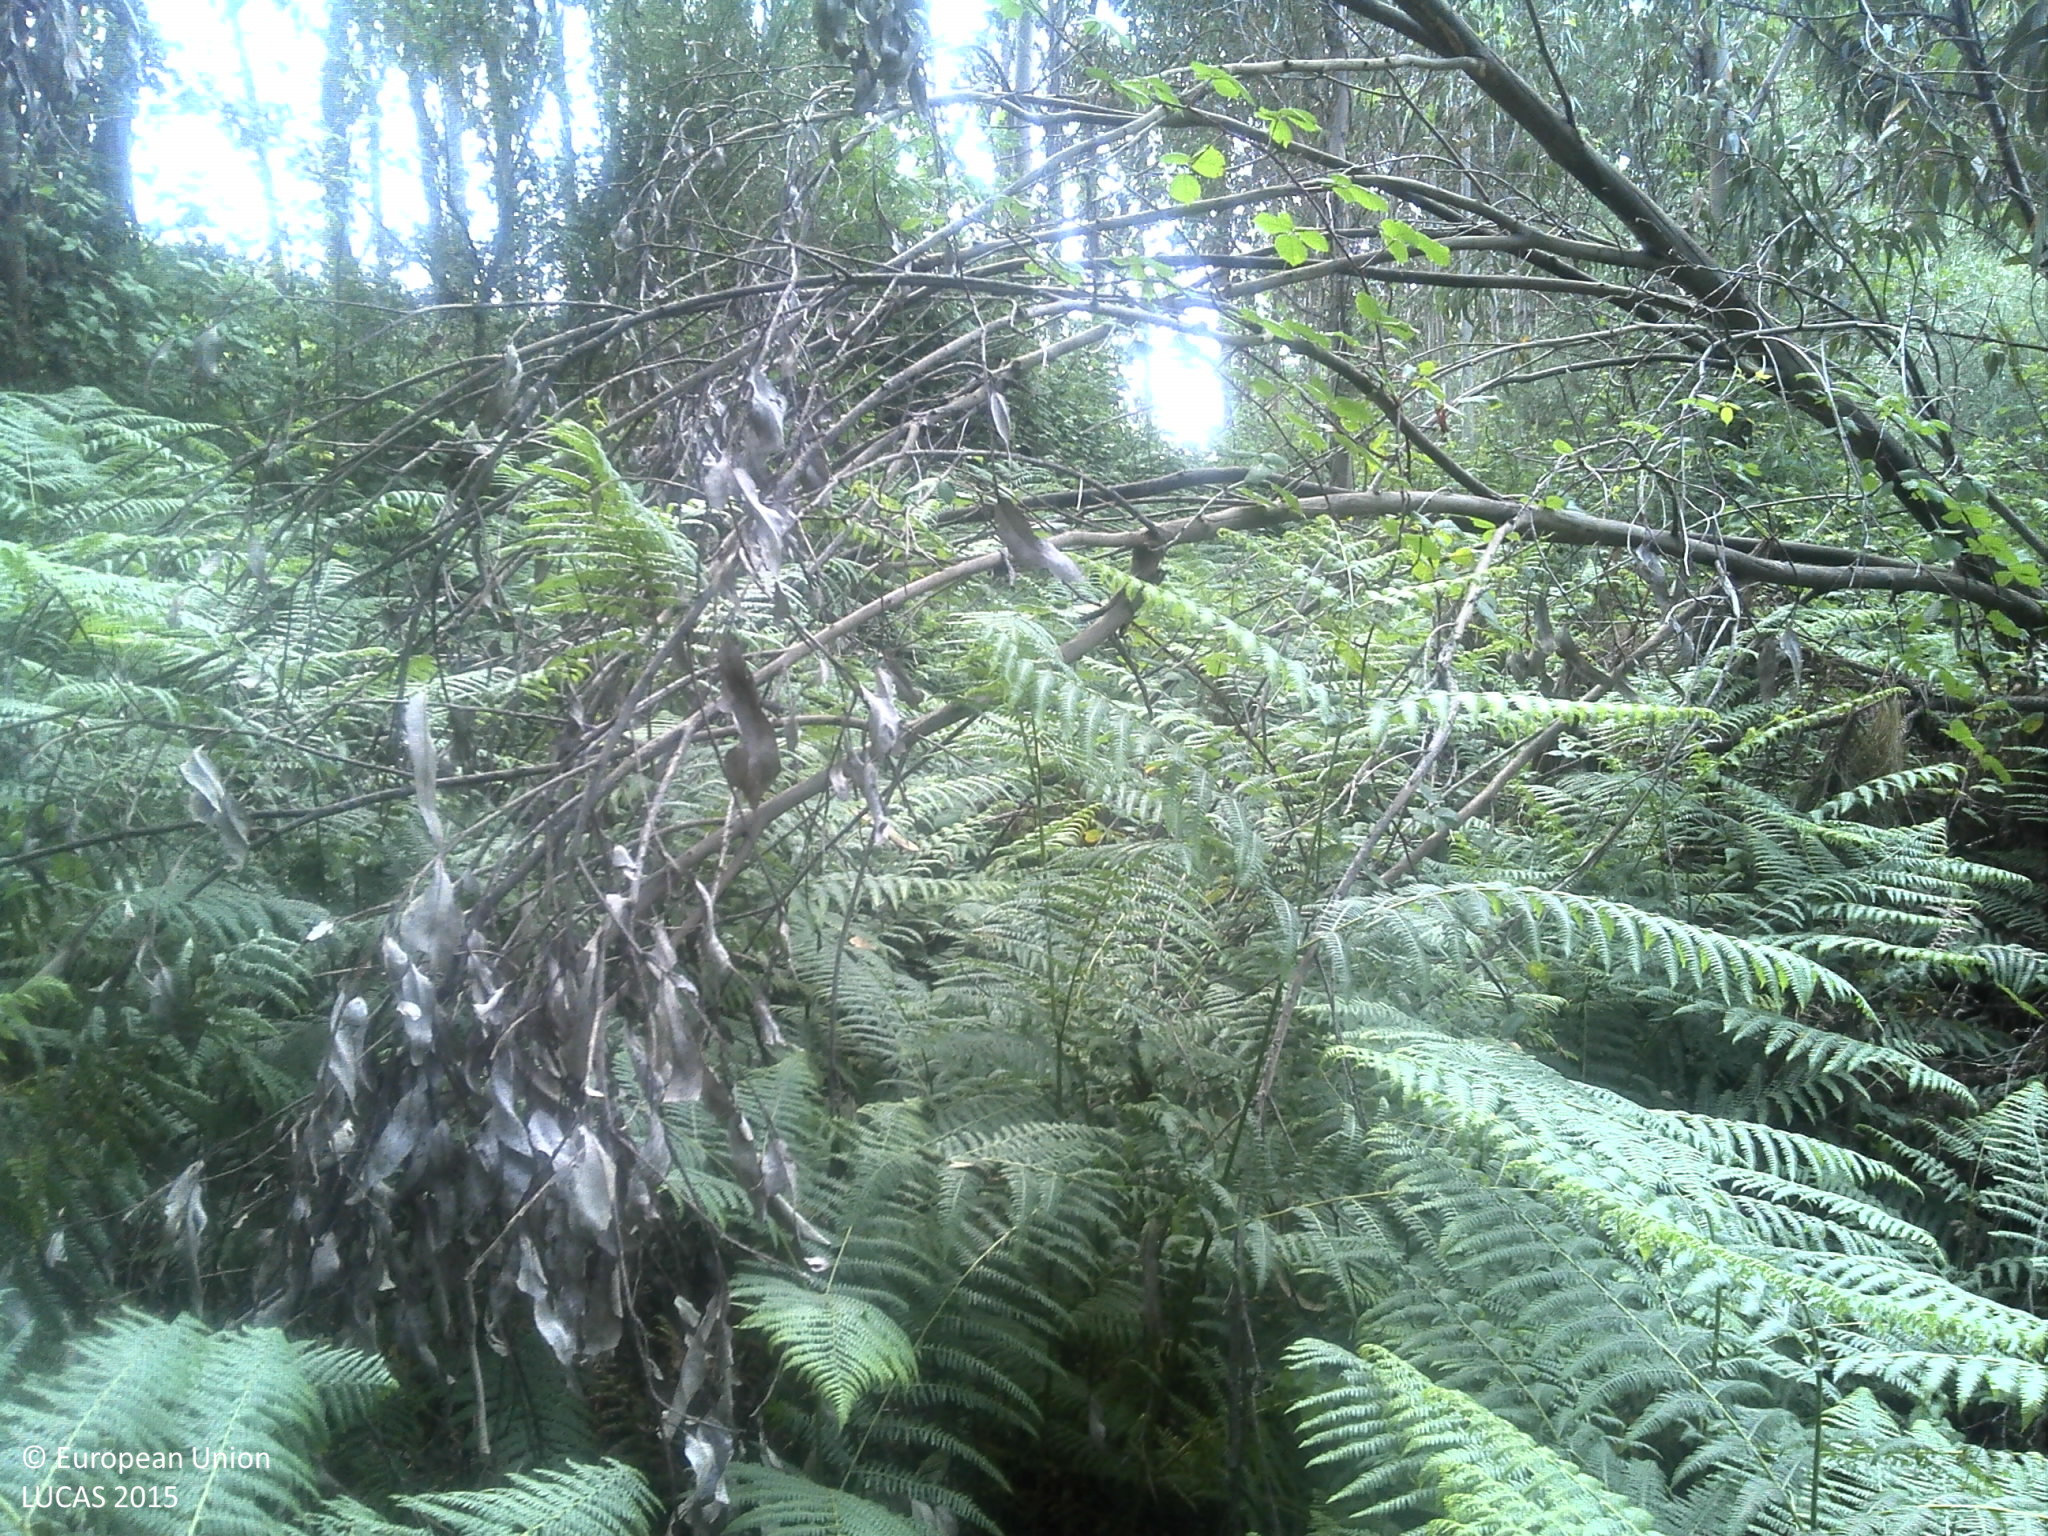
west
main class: Woodland
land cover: Broadleaved woodland
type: exotic forest
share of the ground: 50 - 75 %
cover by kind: broadleaved forest trees 70 %, shrubs 20 %, herbaceous plants 10 %
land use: Forestry
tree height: > 5 m
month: June
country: PT
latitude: 41.6629
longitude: -8.3480
